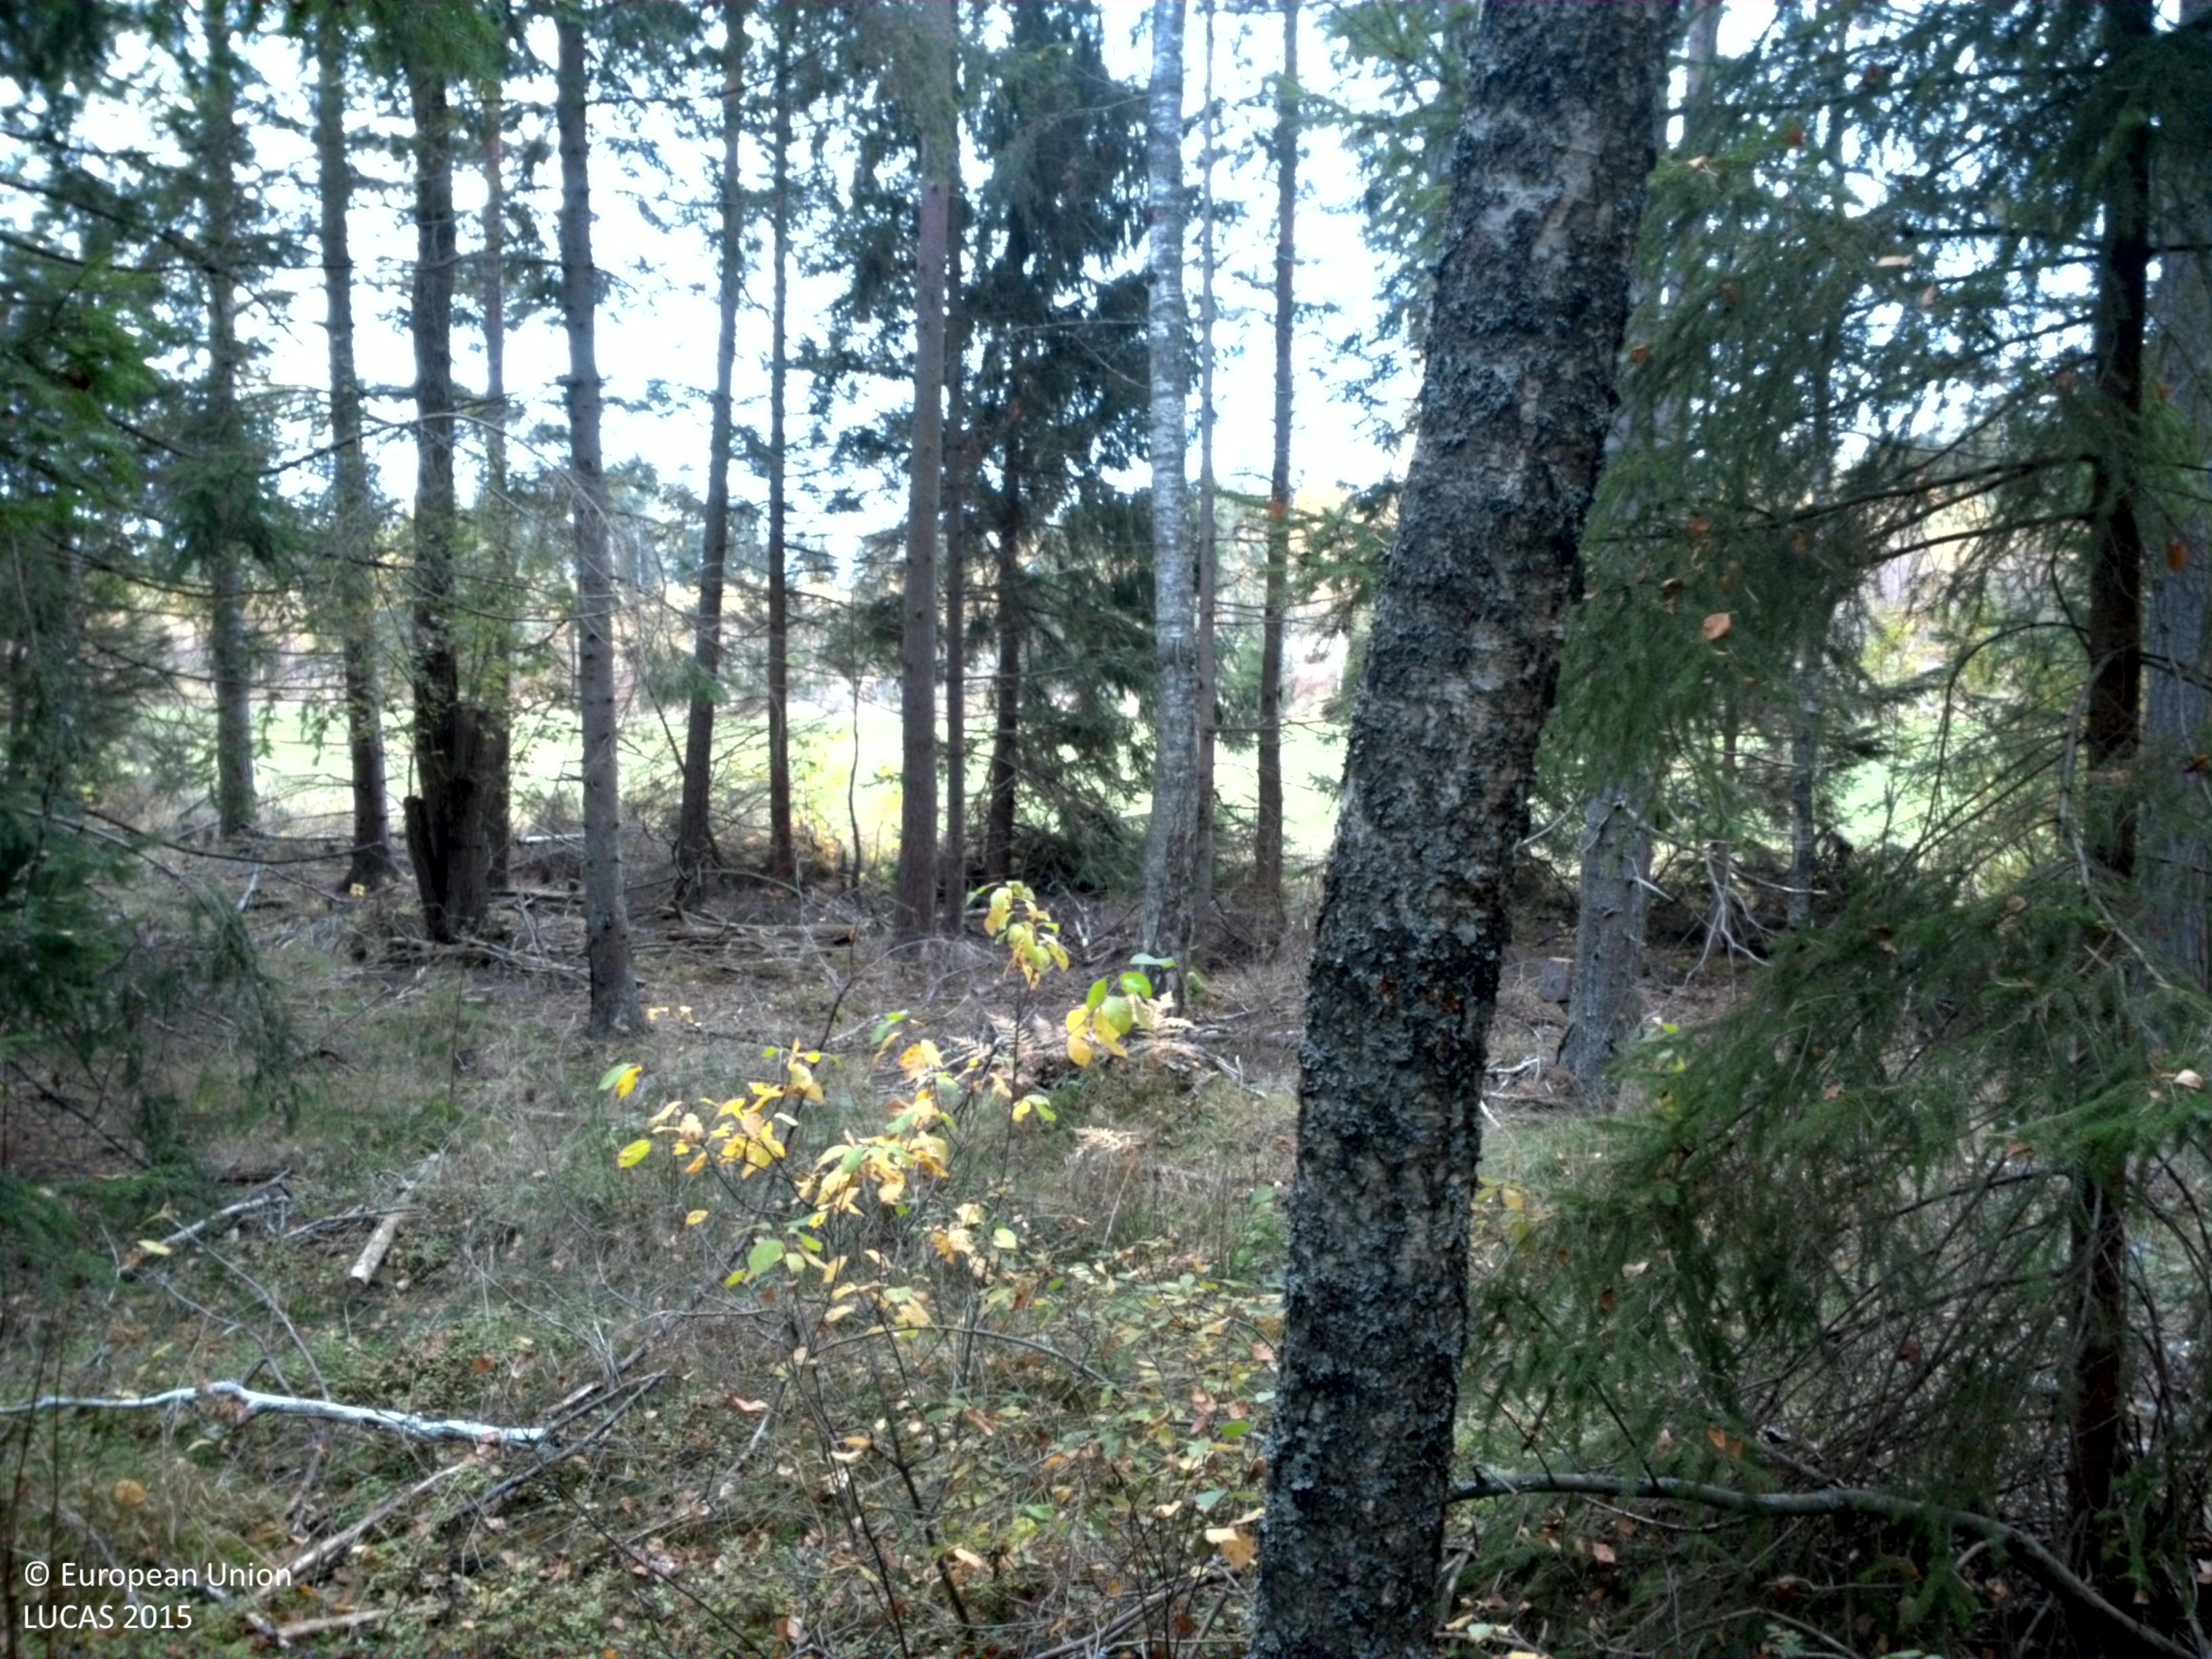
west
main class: Woodland
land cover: Spruce dominated mixed woodland
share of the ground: 25 - 50 %
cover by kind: coniferous forest trees 30 %, broadleaved forest trees 20 %, shrubs 20 %, lichens and mosses 20 %, herbaceous plants 10 %
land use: Forestry
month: October
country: SE
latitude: 58.9937
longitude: 13.1088
